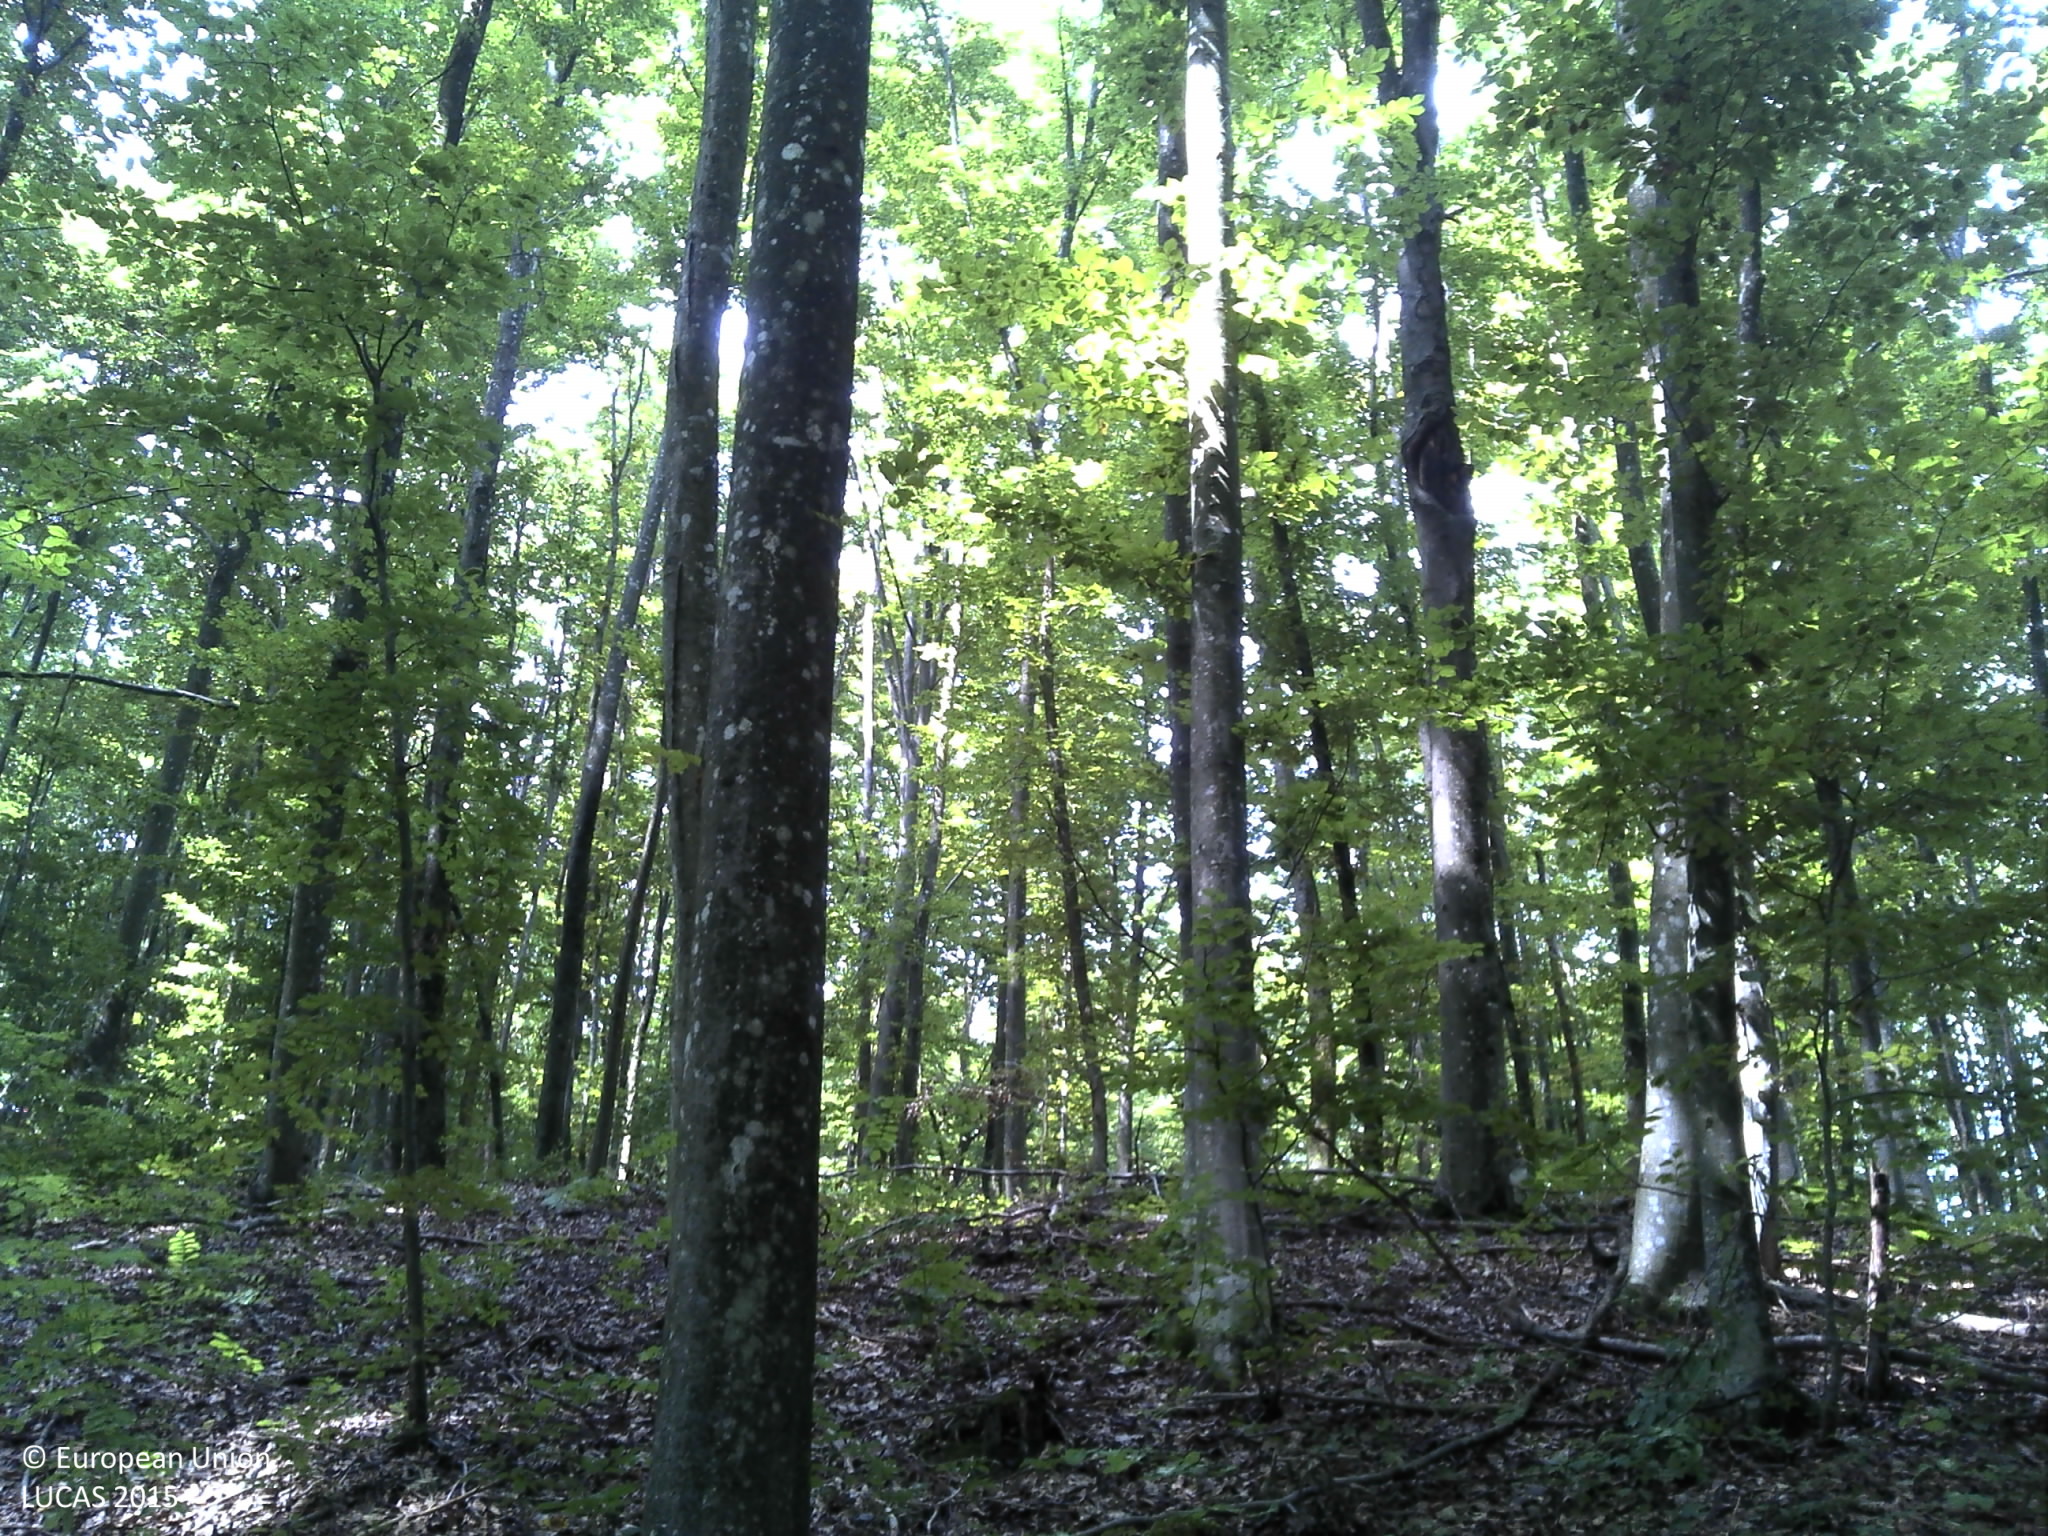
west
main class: Woodland
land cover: Broadleaved woodland
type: beech forest
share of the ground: > 75 %
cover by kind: broadleaved forest trees 100 %
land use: Forestry
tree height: > 5 m
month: August
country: HR
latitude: 45.3462
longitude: 15.7778
